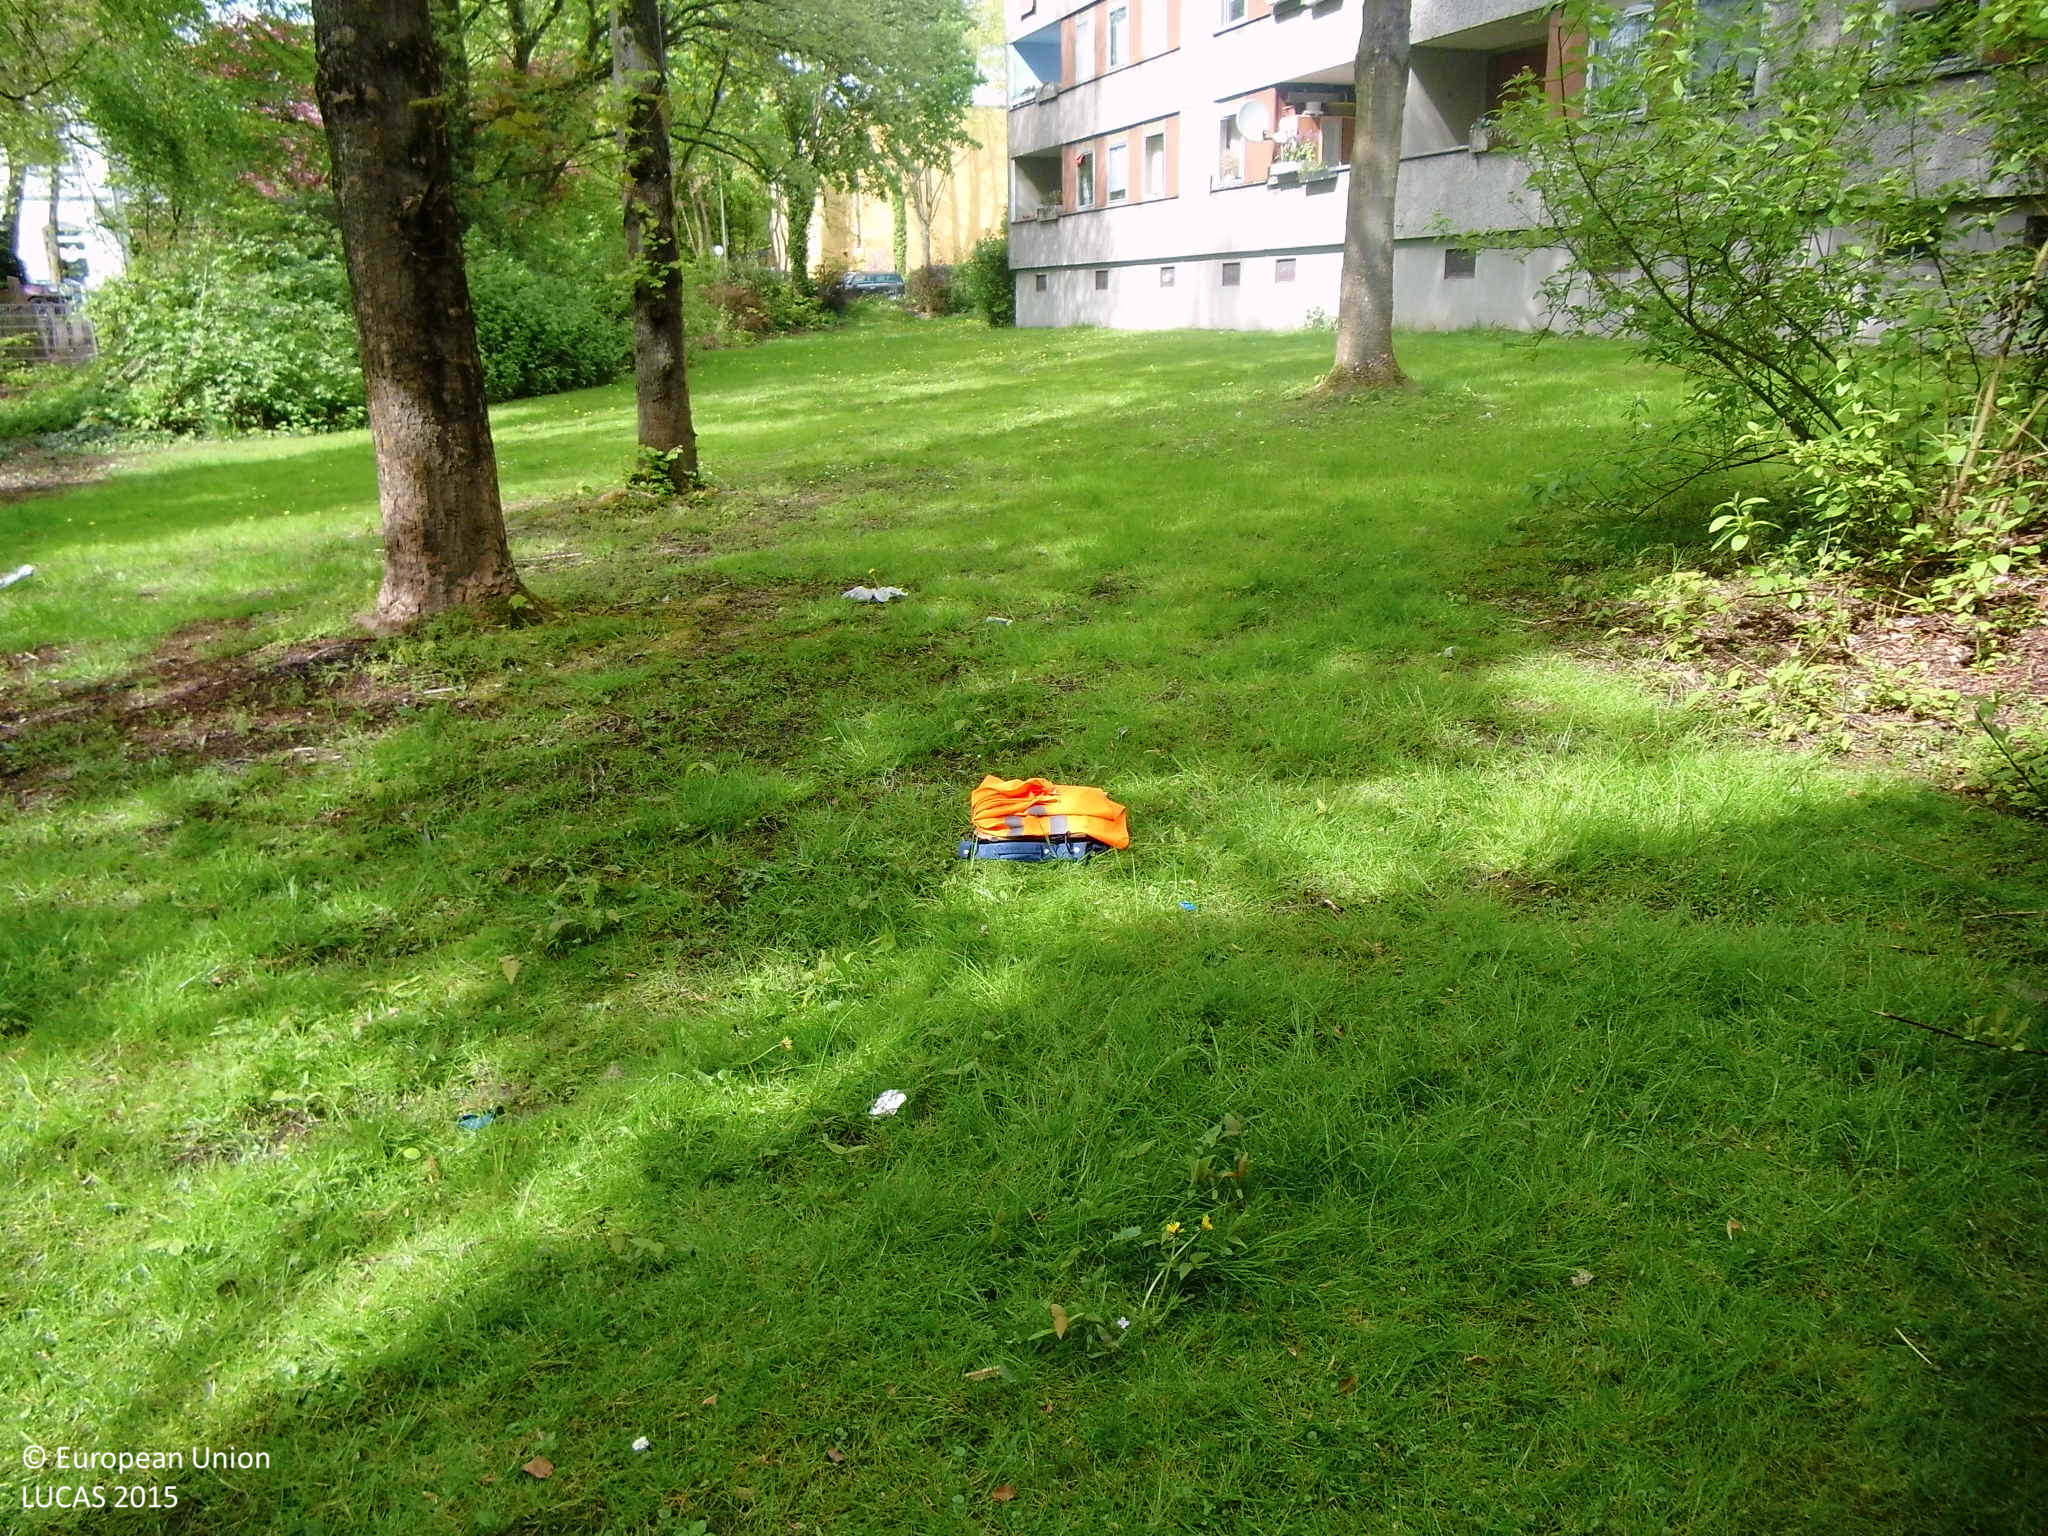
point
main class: Woodland
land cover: Broadleaved woodland
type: mesophytic deciduous forest
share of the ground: > 75 %
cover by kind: broadleaved forest trees 75 %, shrubs 10 %, herbaceous plants 10 %, unconsolidated bare surface 5 %
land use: Residential
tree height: > 5 m
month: May
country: DE
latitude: 51.5575
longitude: 7.3895
